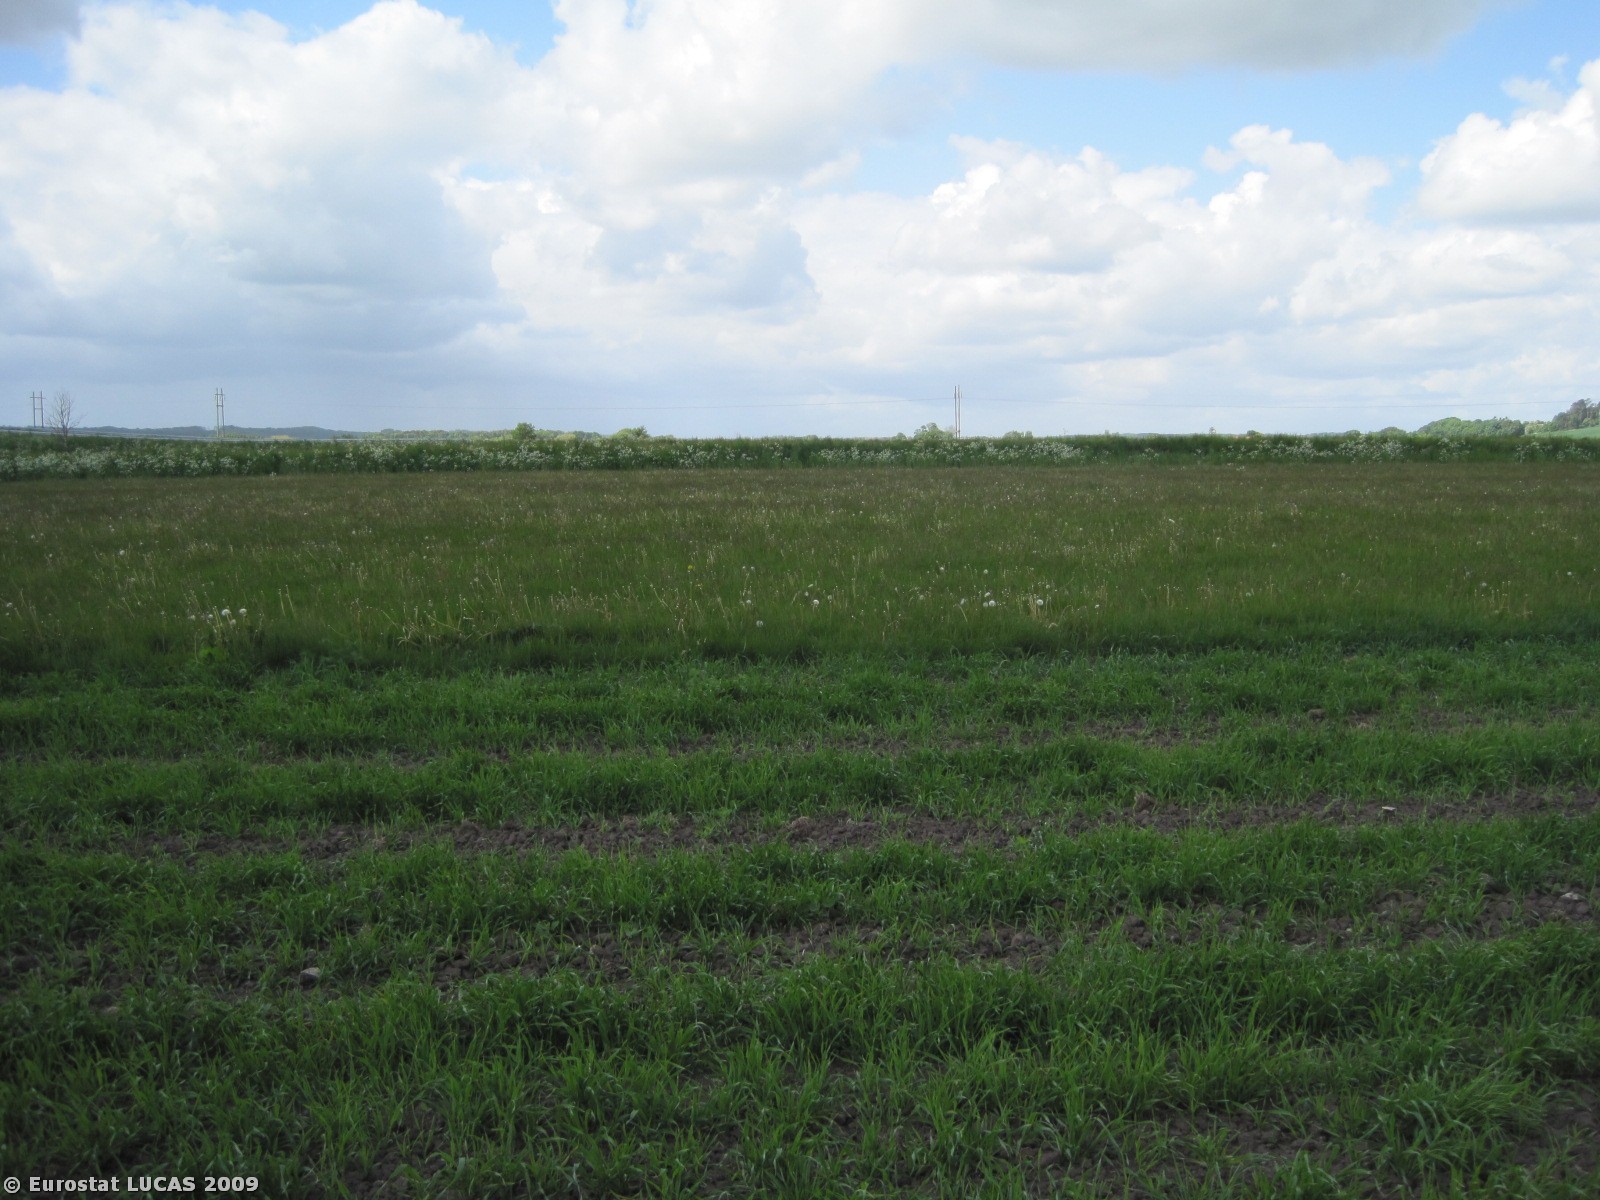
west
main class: Cropland
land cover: Barley
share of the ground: 50 - 75 %
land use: Agriculture (excluding fallow land and kitchen gardens)
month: May
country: DK
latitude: 56.5651
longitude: 9.8212
